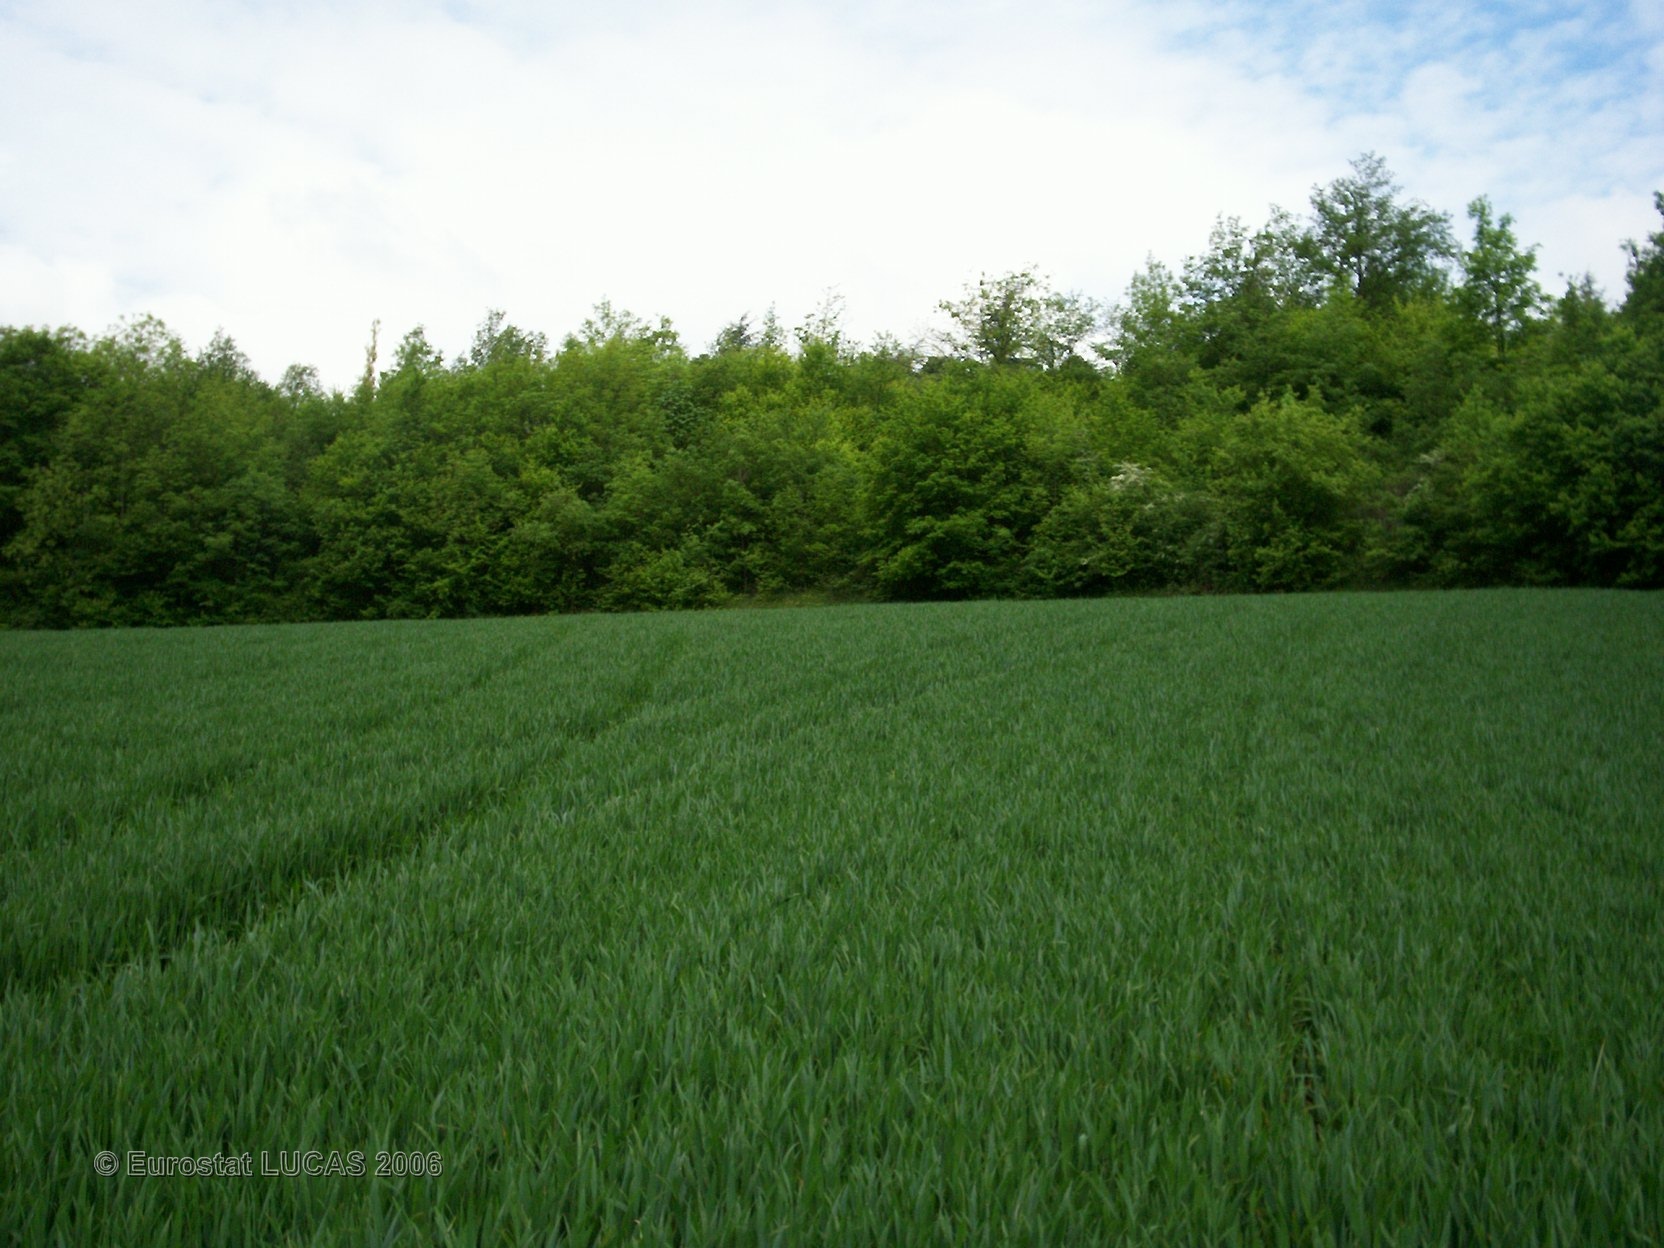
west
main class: Cropland
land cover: Common wheat
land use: Agriculture (excluding fallow land and kitchen gardens)
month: May
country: FR
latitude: 45.8644
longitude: 4.8122
